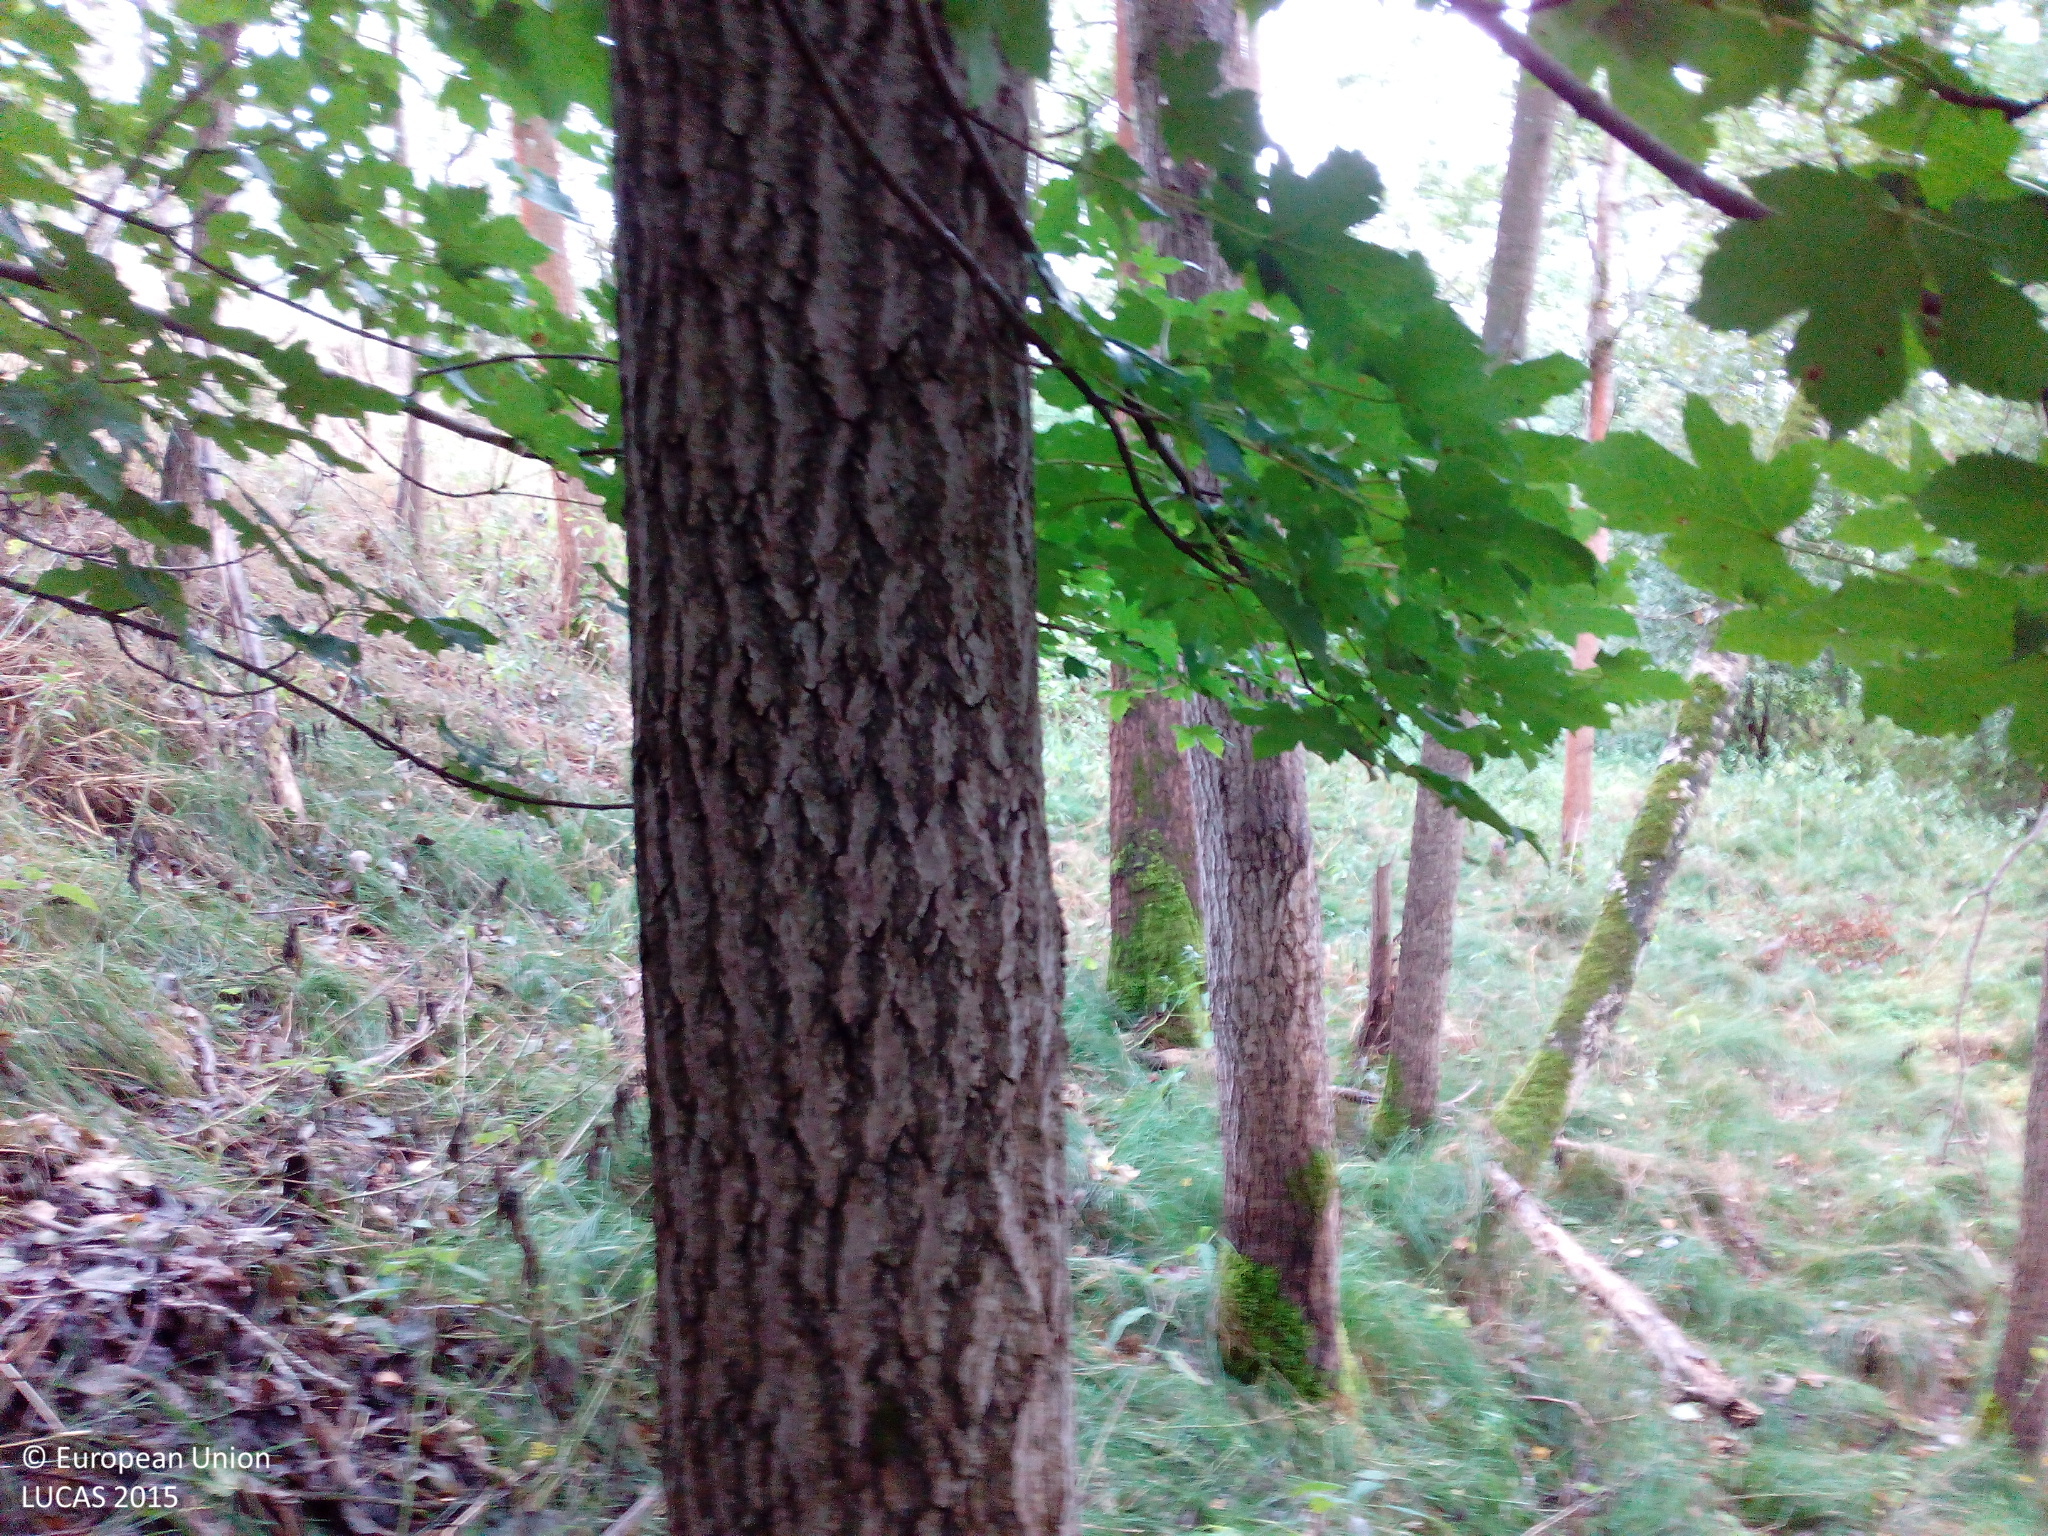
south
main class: Woodland
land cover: Broadleaved woodland
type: floodplain forest
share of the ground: > 75 %
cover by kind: broadleaved forest trees 90 %, herbaceous plants 10 %
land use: Semi-natural and natural areas not in use
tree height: > 5 m
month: August
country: DE
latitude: 50.1292
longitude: 12.0839
